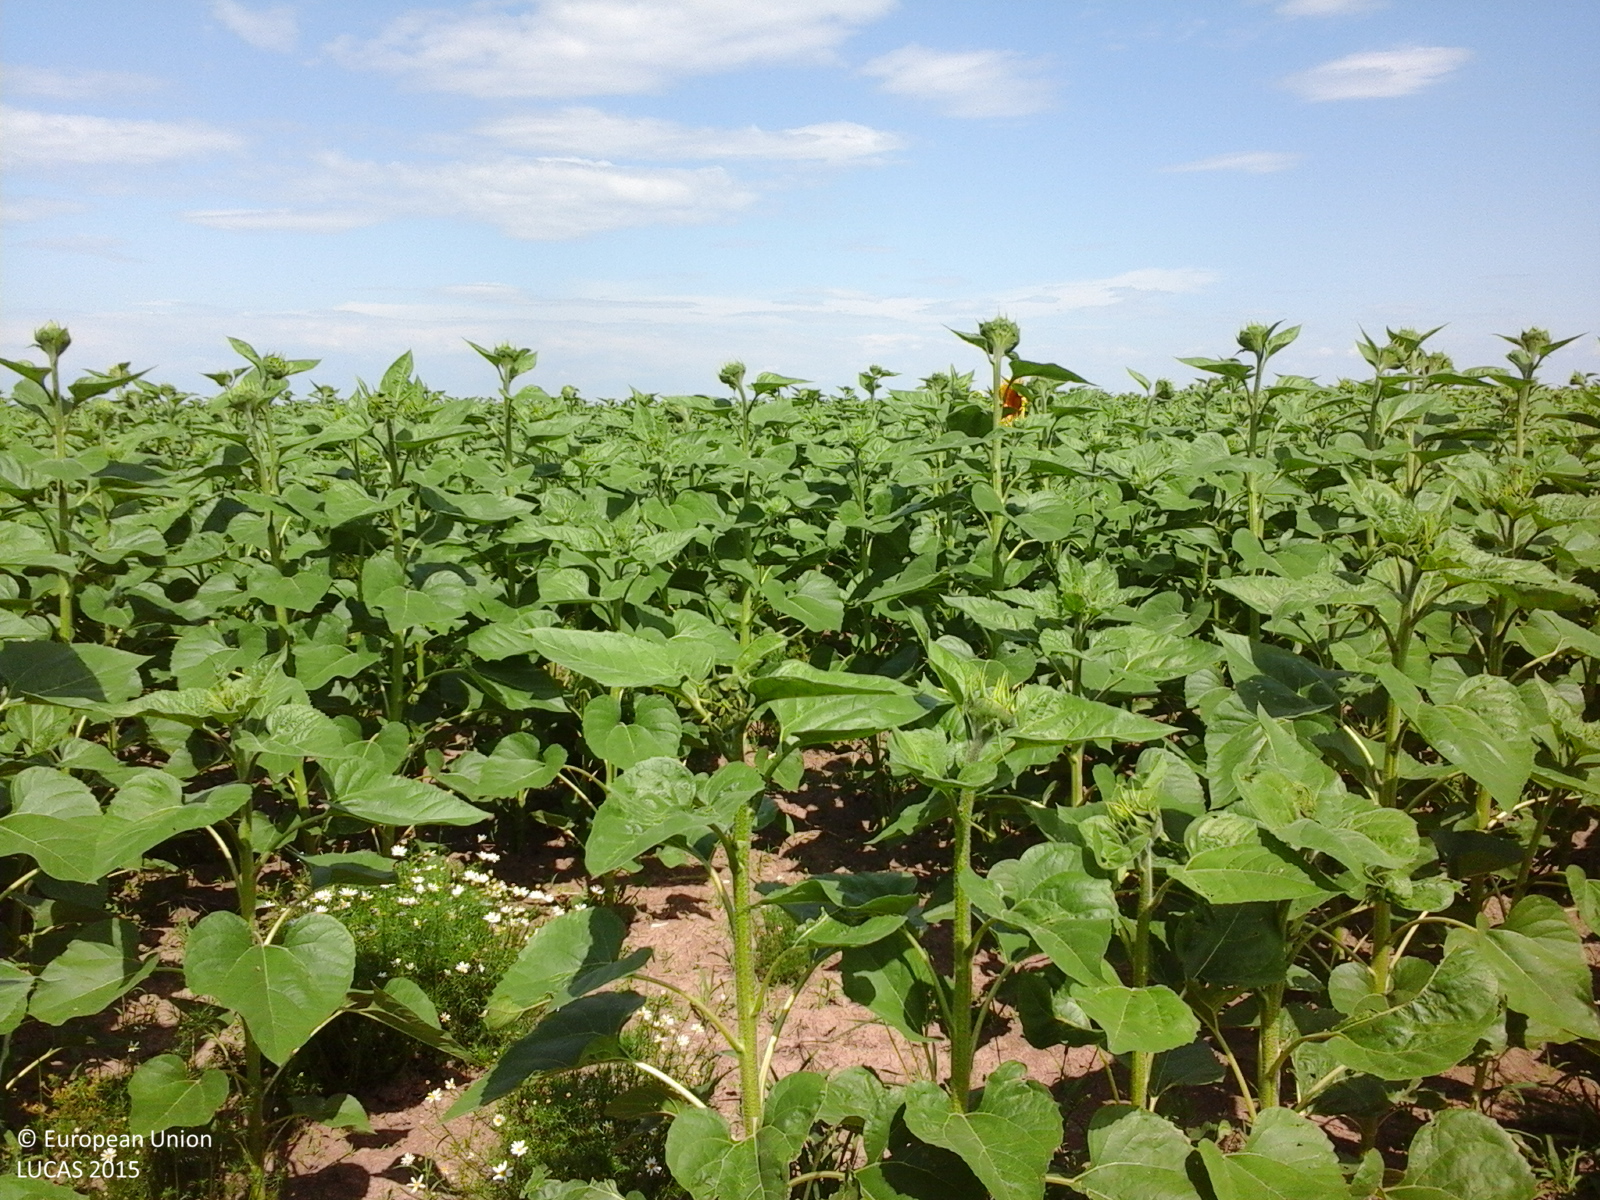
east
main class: Cropland
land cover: Sunflower
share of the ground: > 75 %
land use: Agriculture (excluding fallow land and kitchen gardens)
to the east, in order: Sunflower; Grass margins; Common wheat; Spontaneously vegetated surfaces; Maize; Spontaneously vegetated surfaces; Sunflower
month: July
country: RO
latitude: 44.3319
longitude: 24.7601
